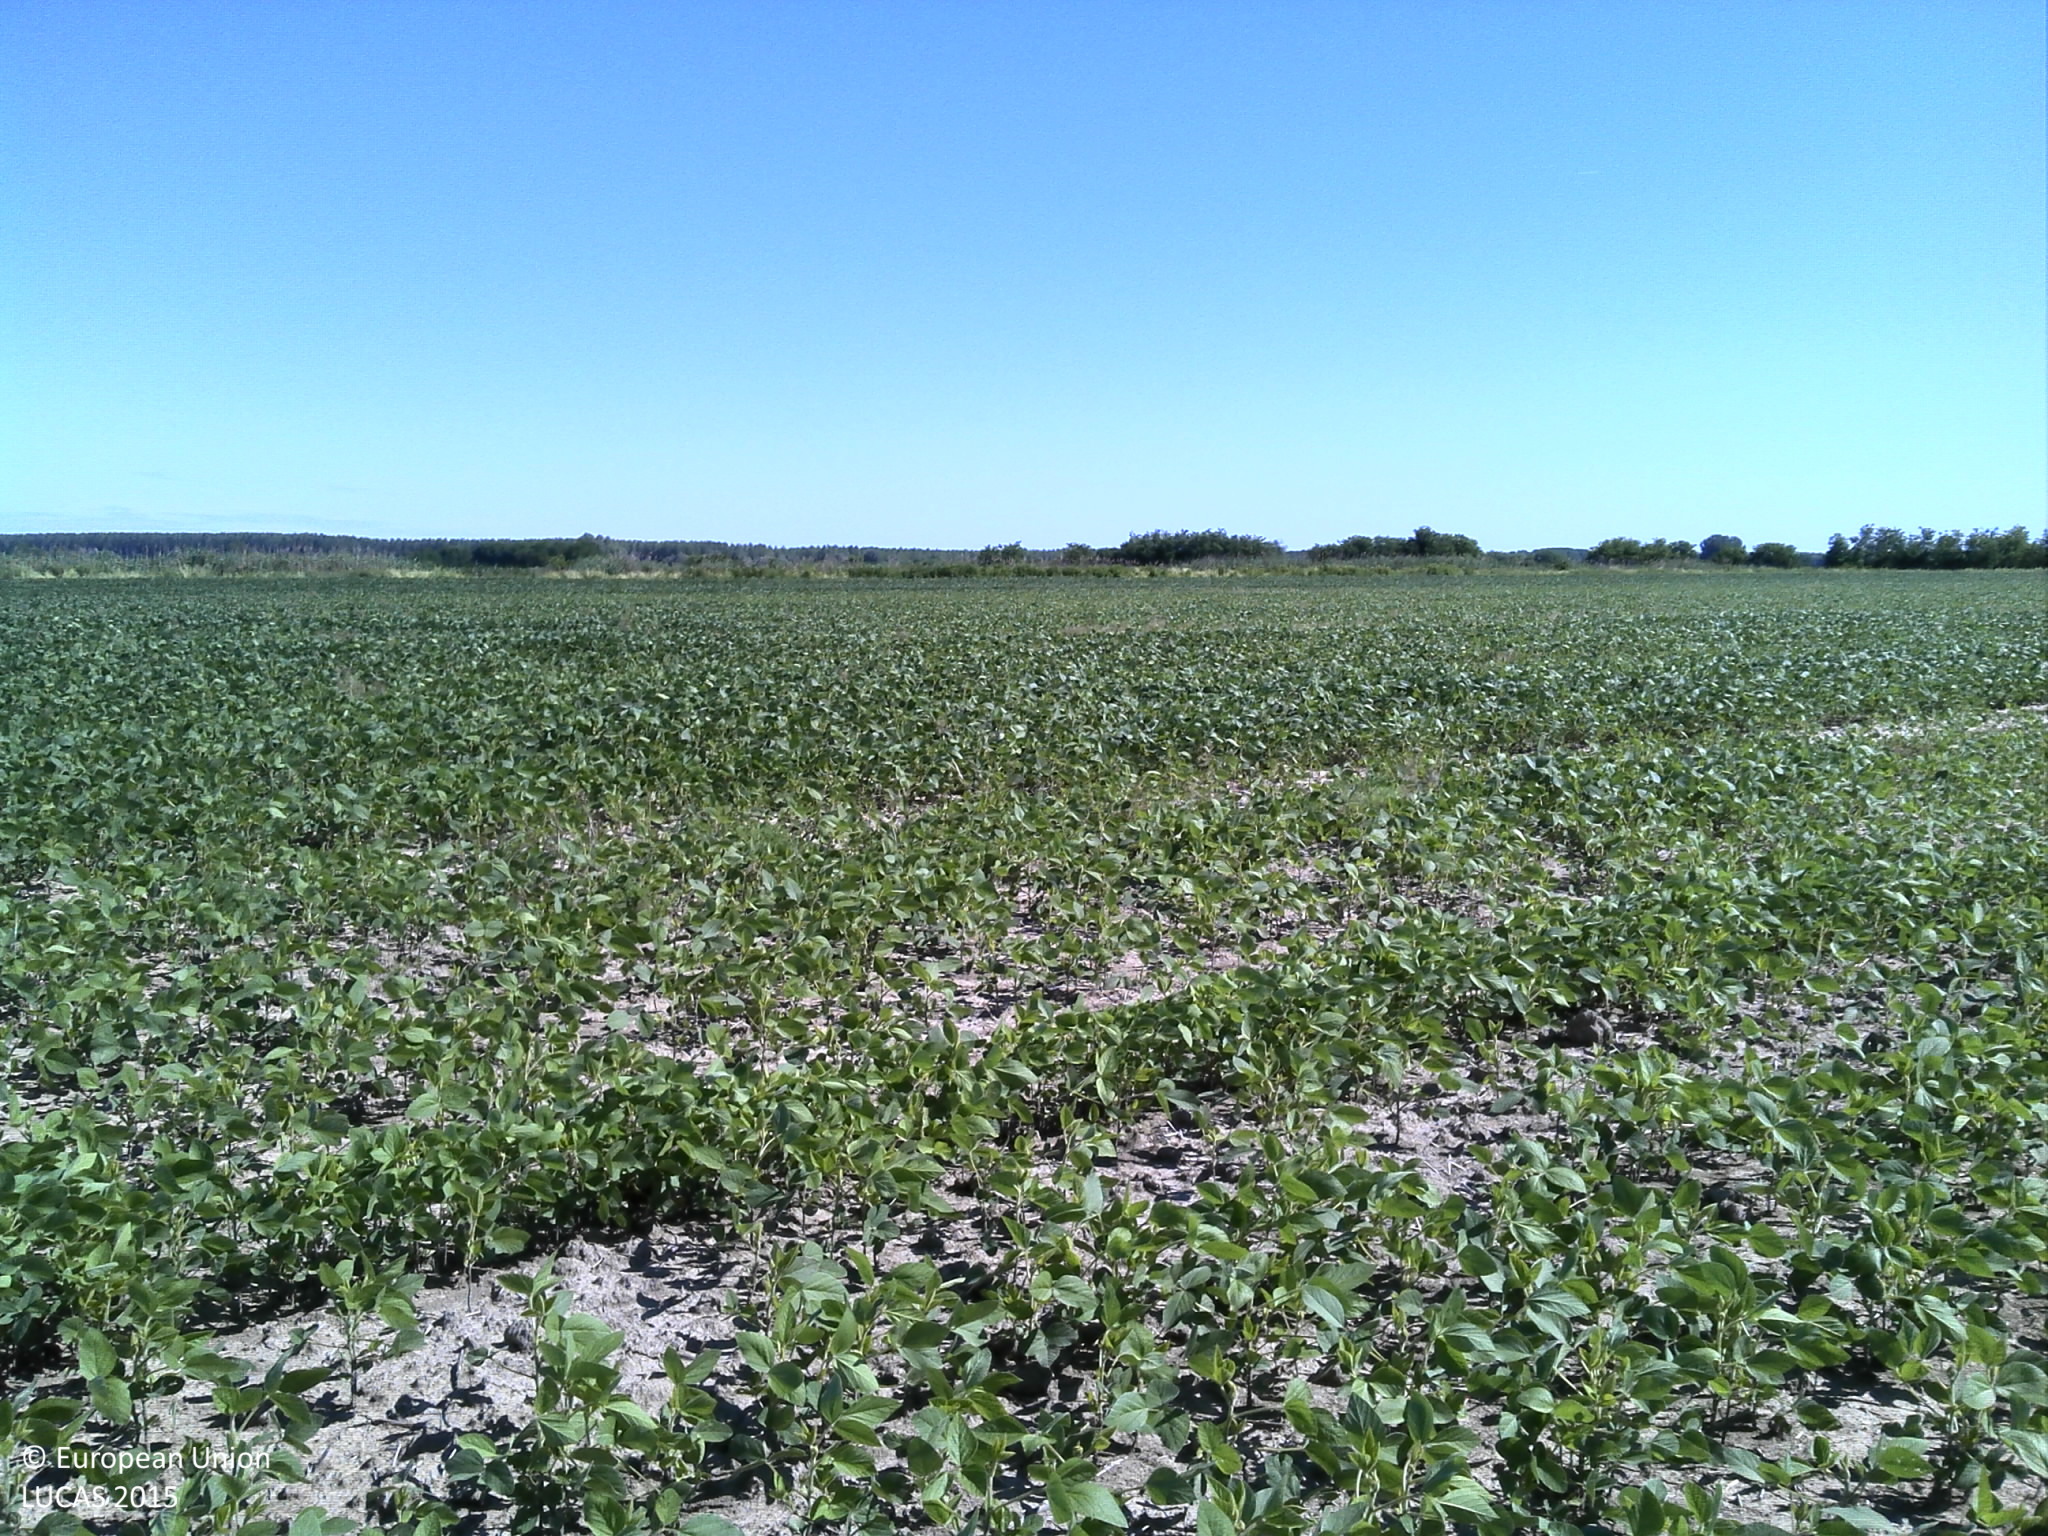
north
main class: Cropland
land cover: Soya
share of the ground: 50 - 75 %
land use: Agriculture (excluding fallow land and kitchen gardens)
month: June
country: HR
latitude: 45.7663
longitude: 17.9381
